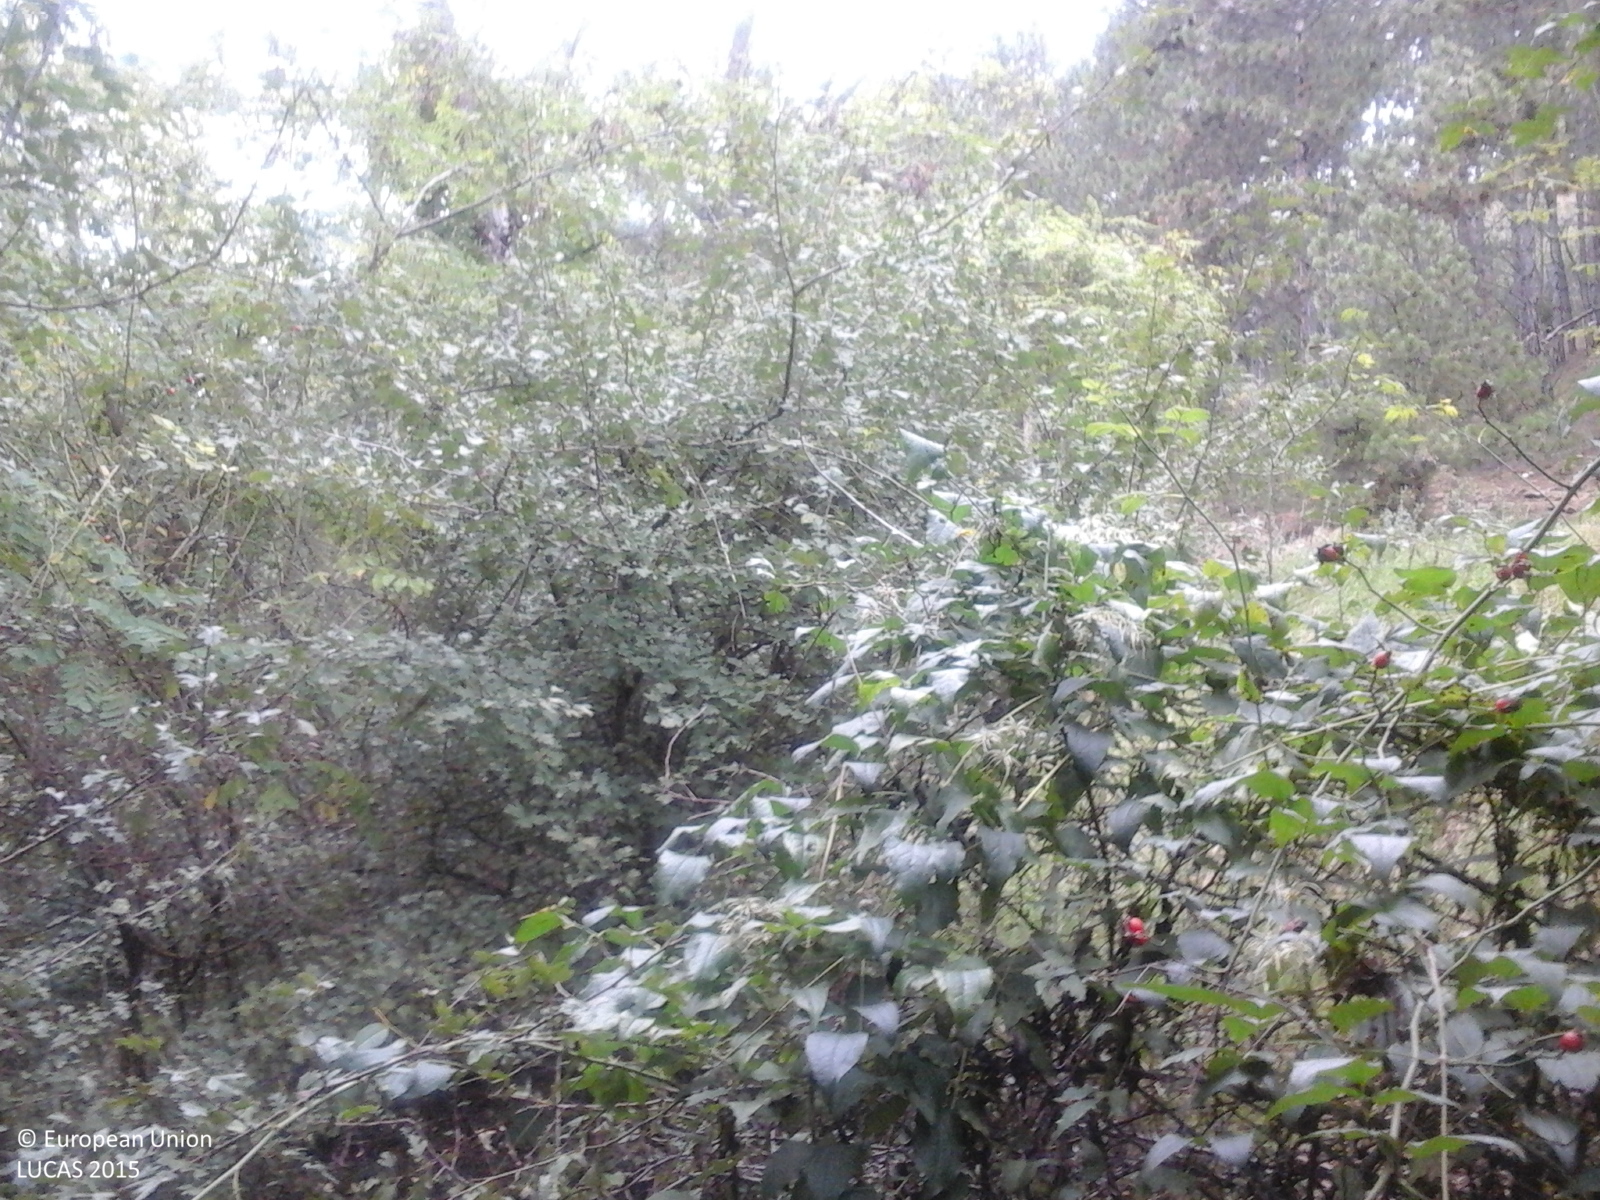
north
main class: Woodland
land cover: Broadleaved woodland
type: exotic forest
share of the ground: > 75 %
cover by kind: broadleaved forest trees 100 %
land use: Forestry
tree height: > 5 m
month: October
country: RO
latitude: 46.0460
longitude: 23.4392
